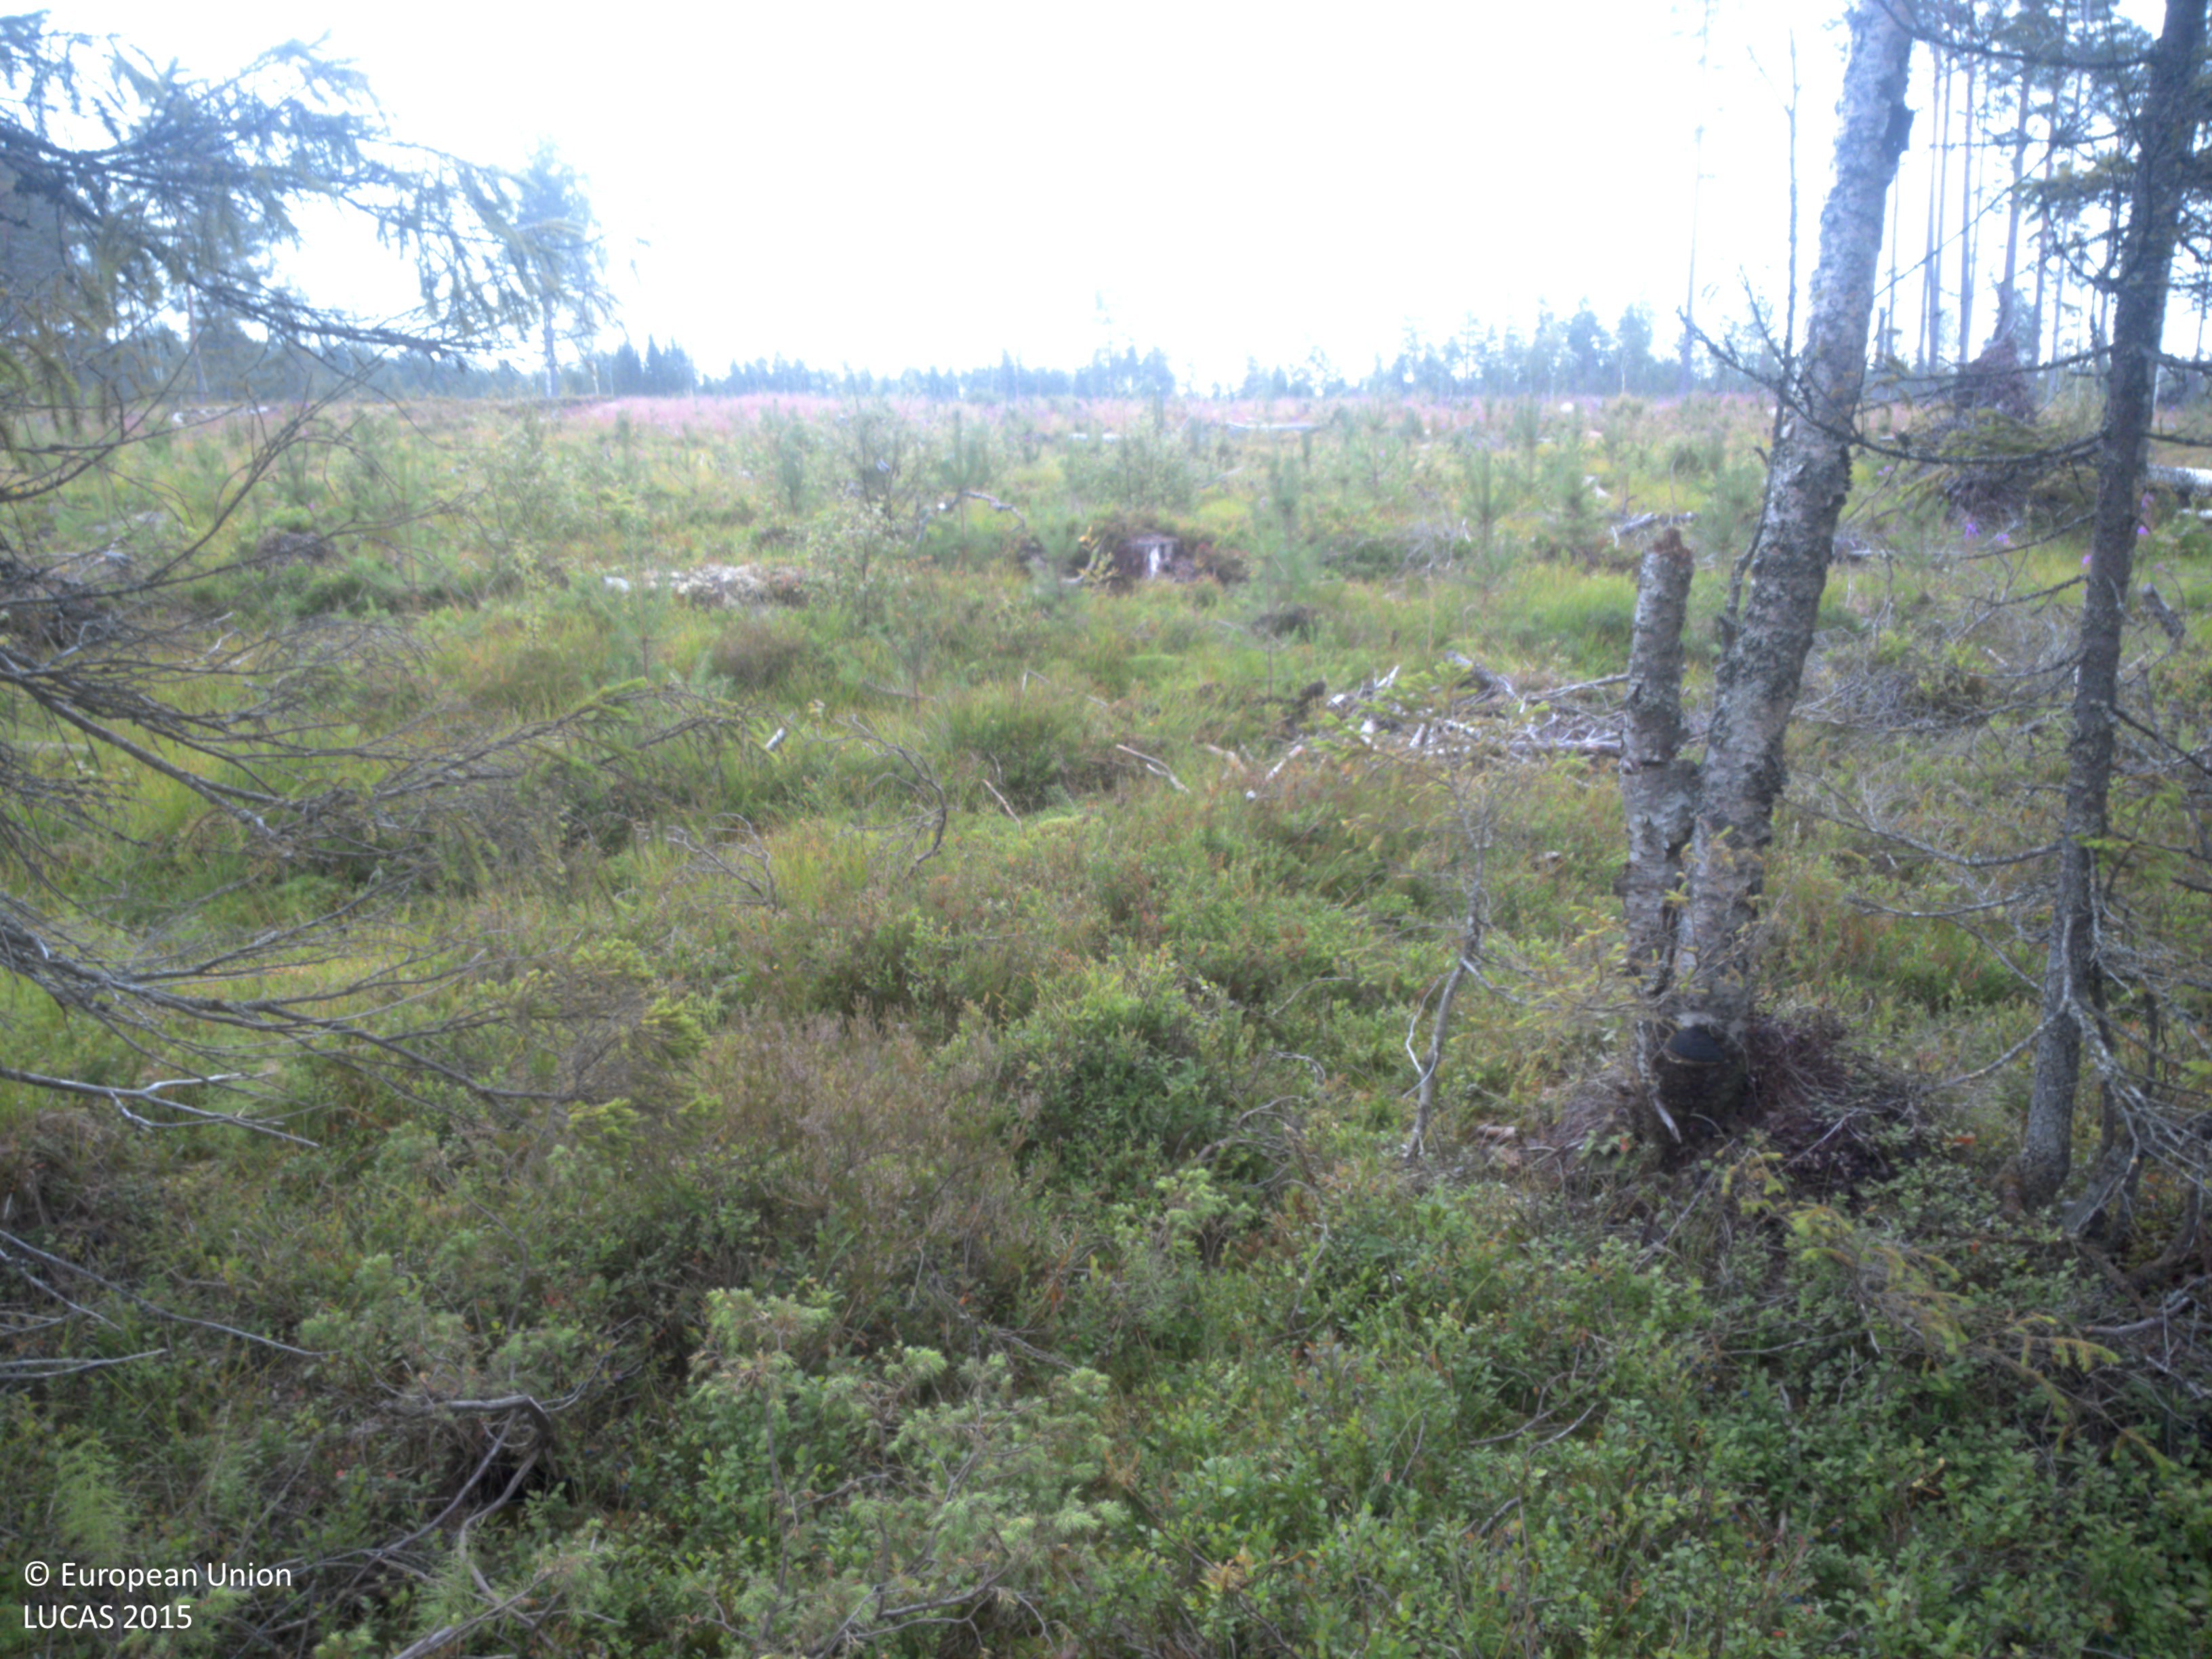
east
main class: Woodland
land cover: Pine dominated coniferous woodland
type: boreal forest
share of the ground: 25 - 50 %
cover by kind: shrubs 55 %, coniferous forest trees 45 %
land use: Forestry
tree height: > 5 m
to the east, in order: Pine dominated coniferous woodland; Shrubland with sparse tree cover; Pine dominated coniferous woodland
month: August
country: SE
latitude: 63.7072
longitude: 19.8751
